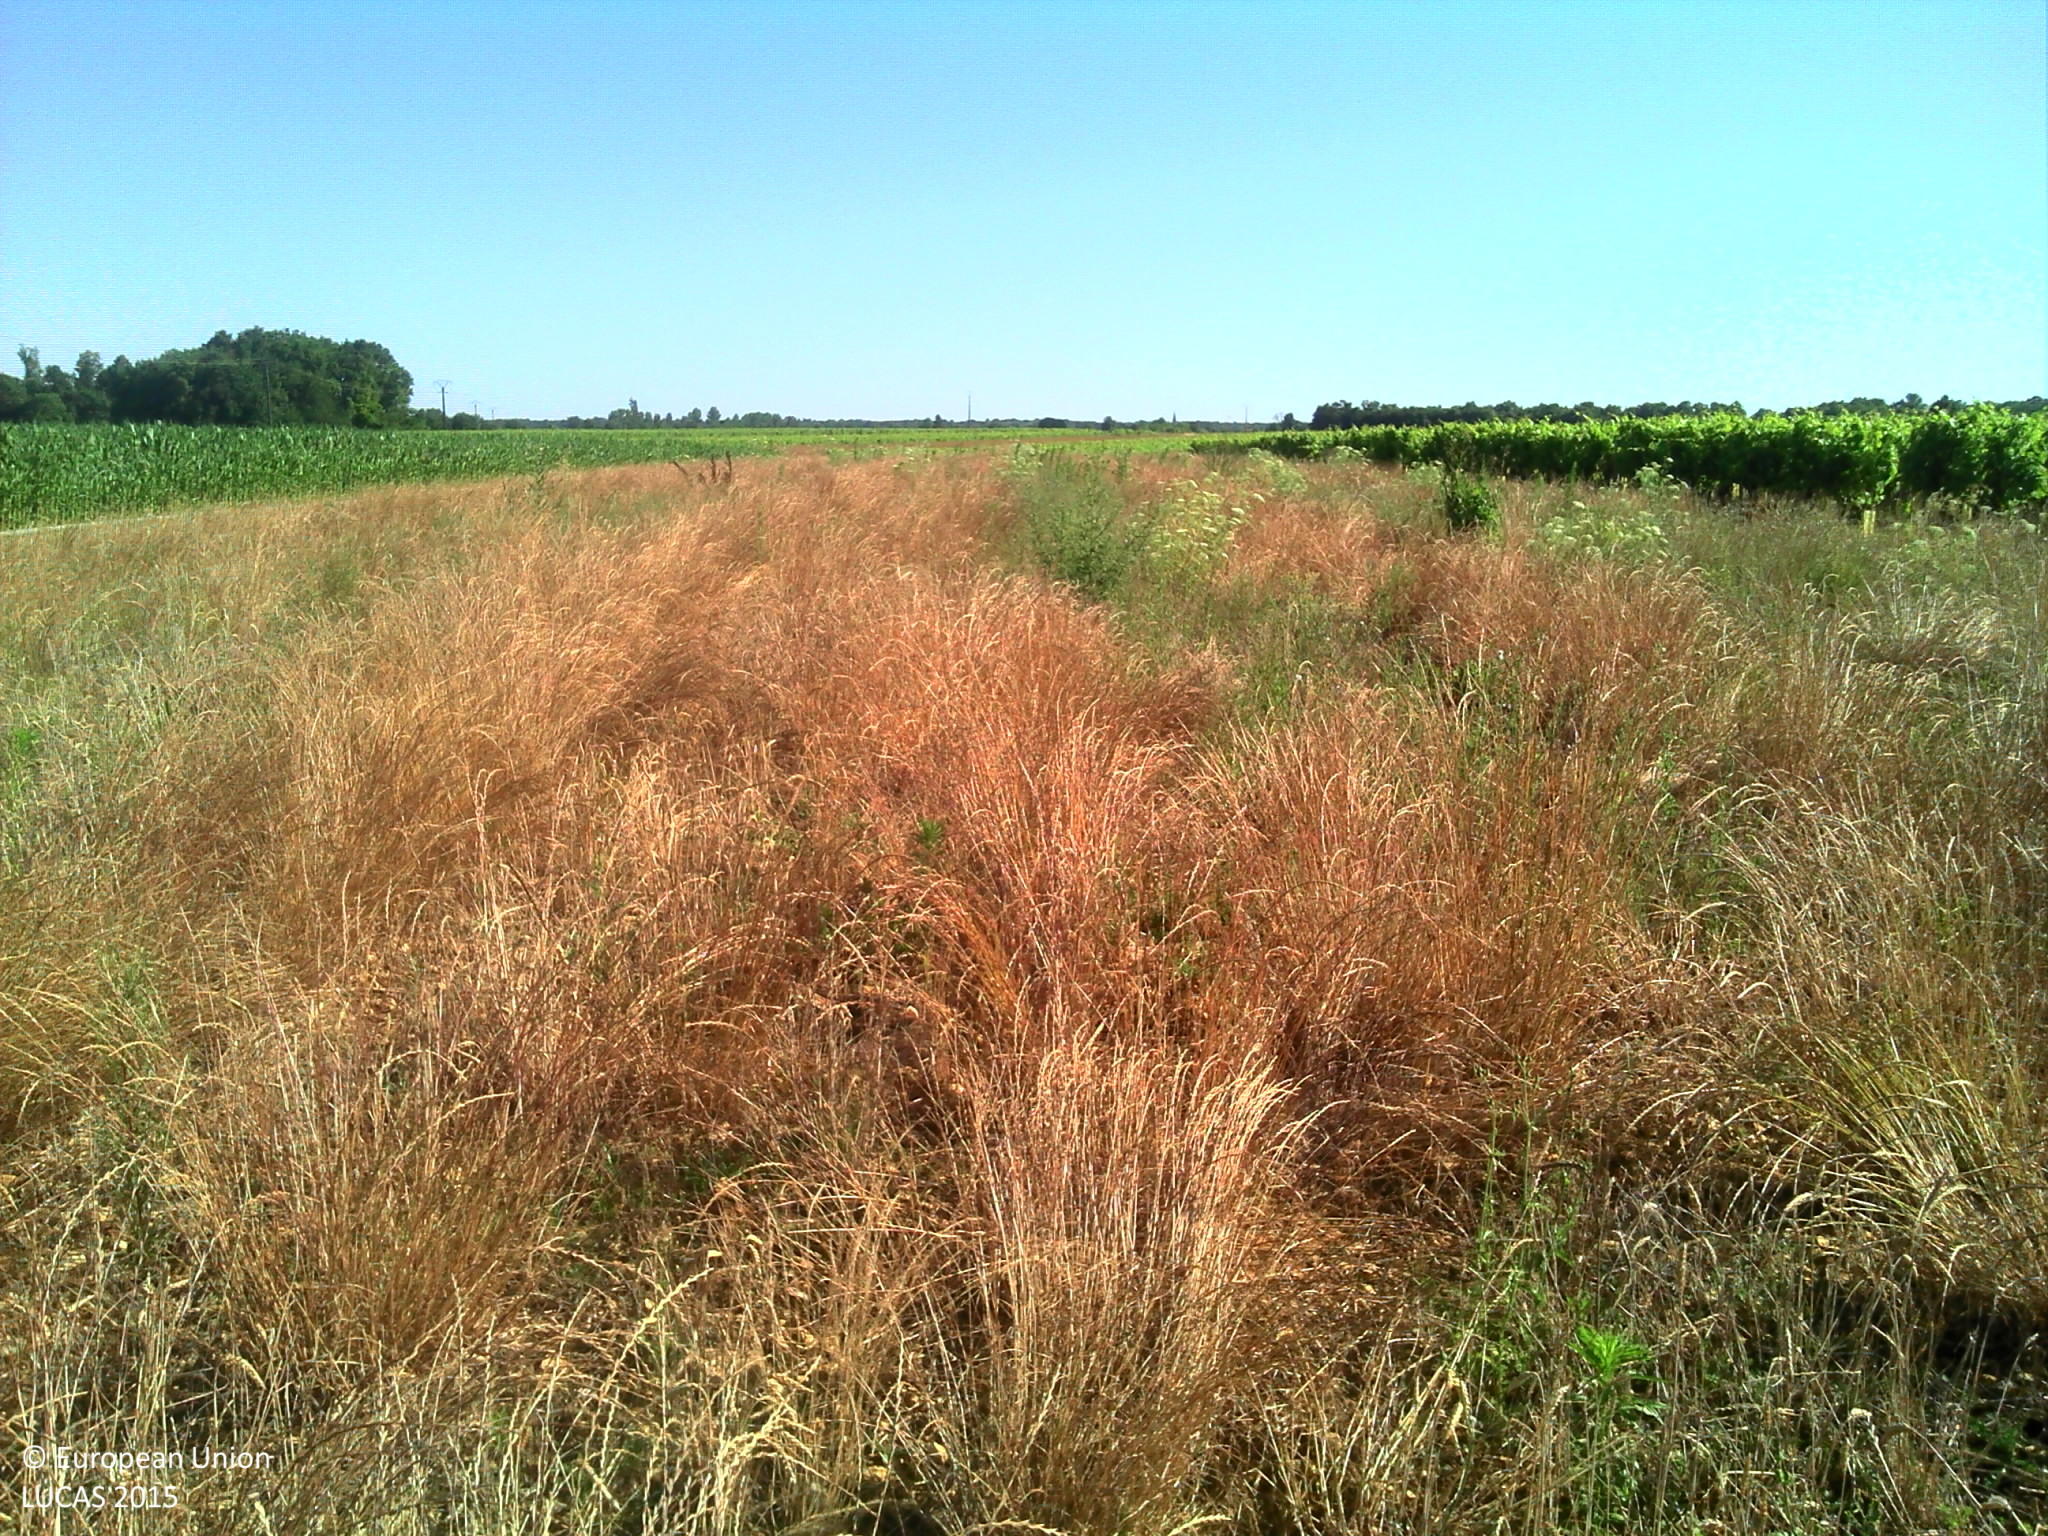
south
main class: Grassland
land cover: Spontaneously vegetated surfaces
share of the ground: > 75 %
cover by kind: herbaceous plants 100 %
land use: Agriculture (excluding fallow land and kitchen gardens)
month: June
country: FR
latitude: 45.5260
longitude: -0.6630
